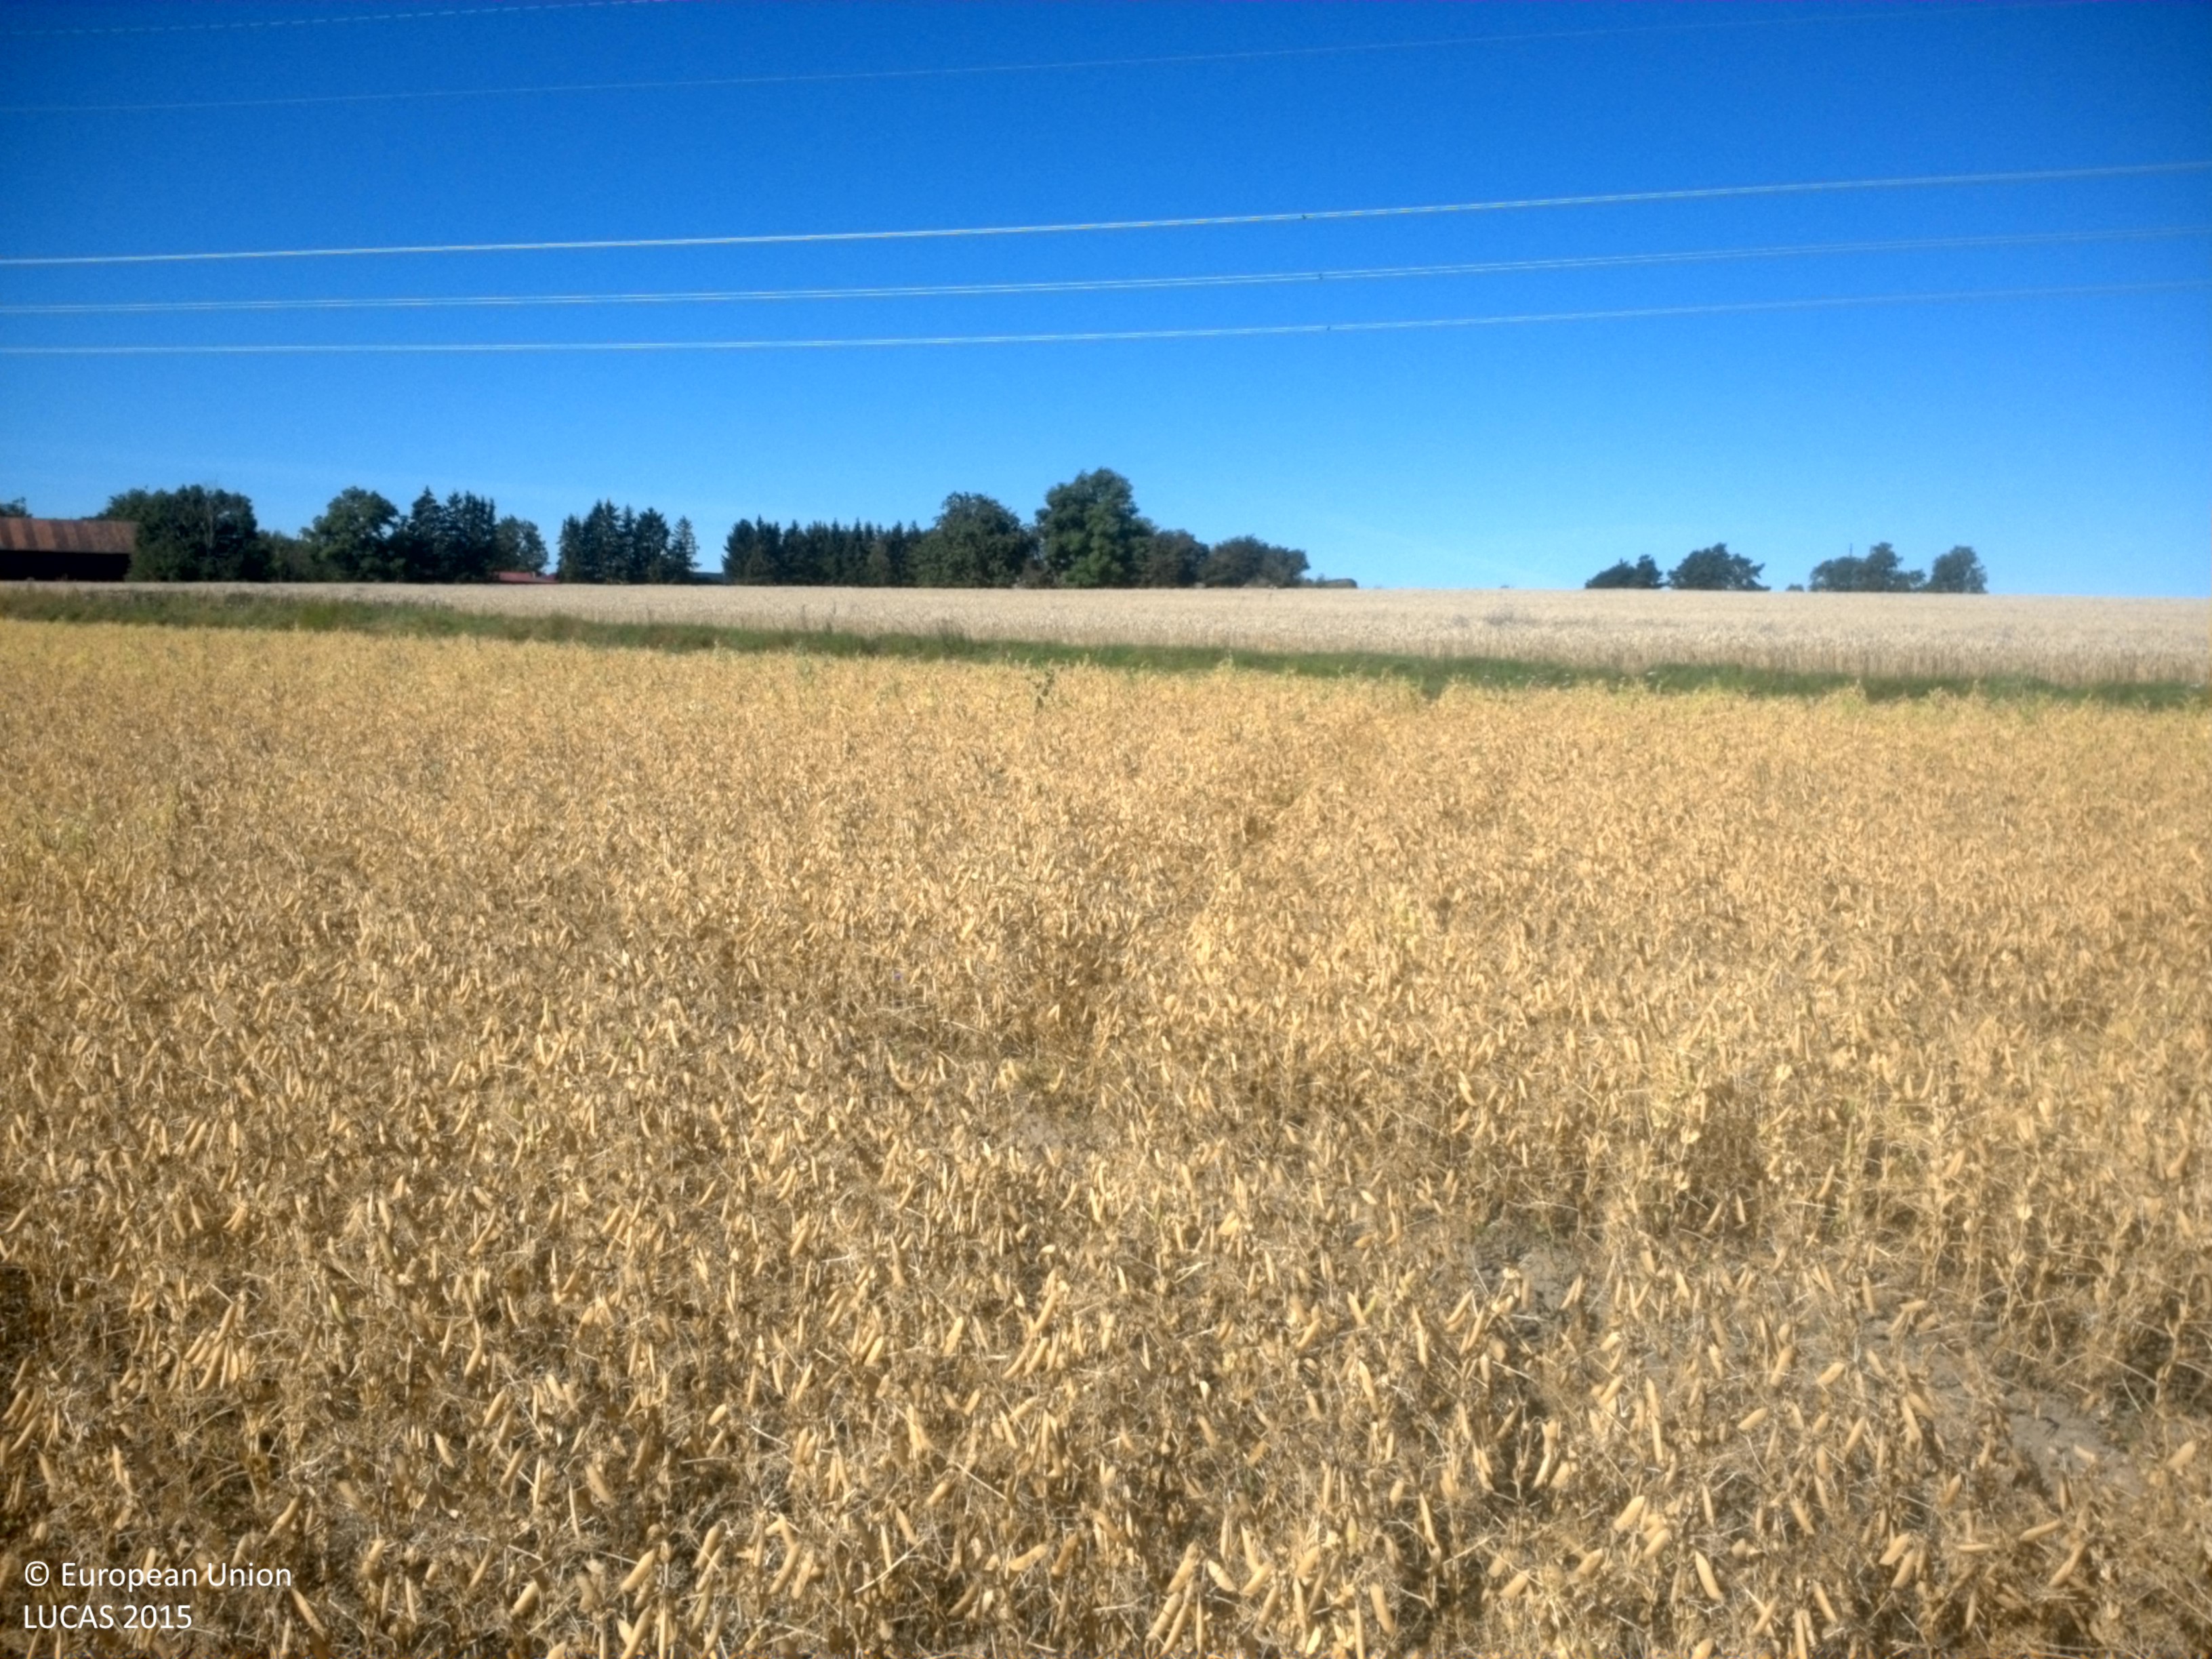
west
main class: Cropland
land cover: Dry pulses
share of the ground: > 75 %
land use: Agriculture (excluding fallow land and kitchen gardens)
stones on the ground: < 10 %
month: August
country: SE
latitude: 59.7239
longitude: 17.2309
